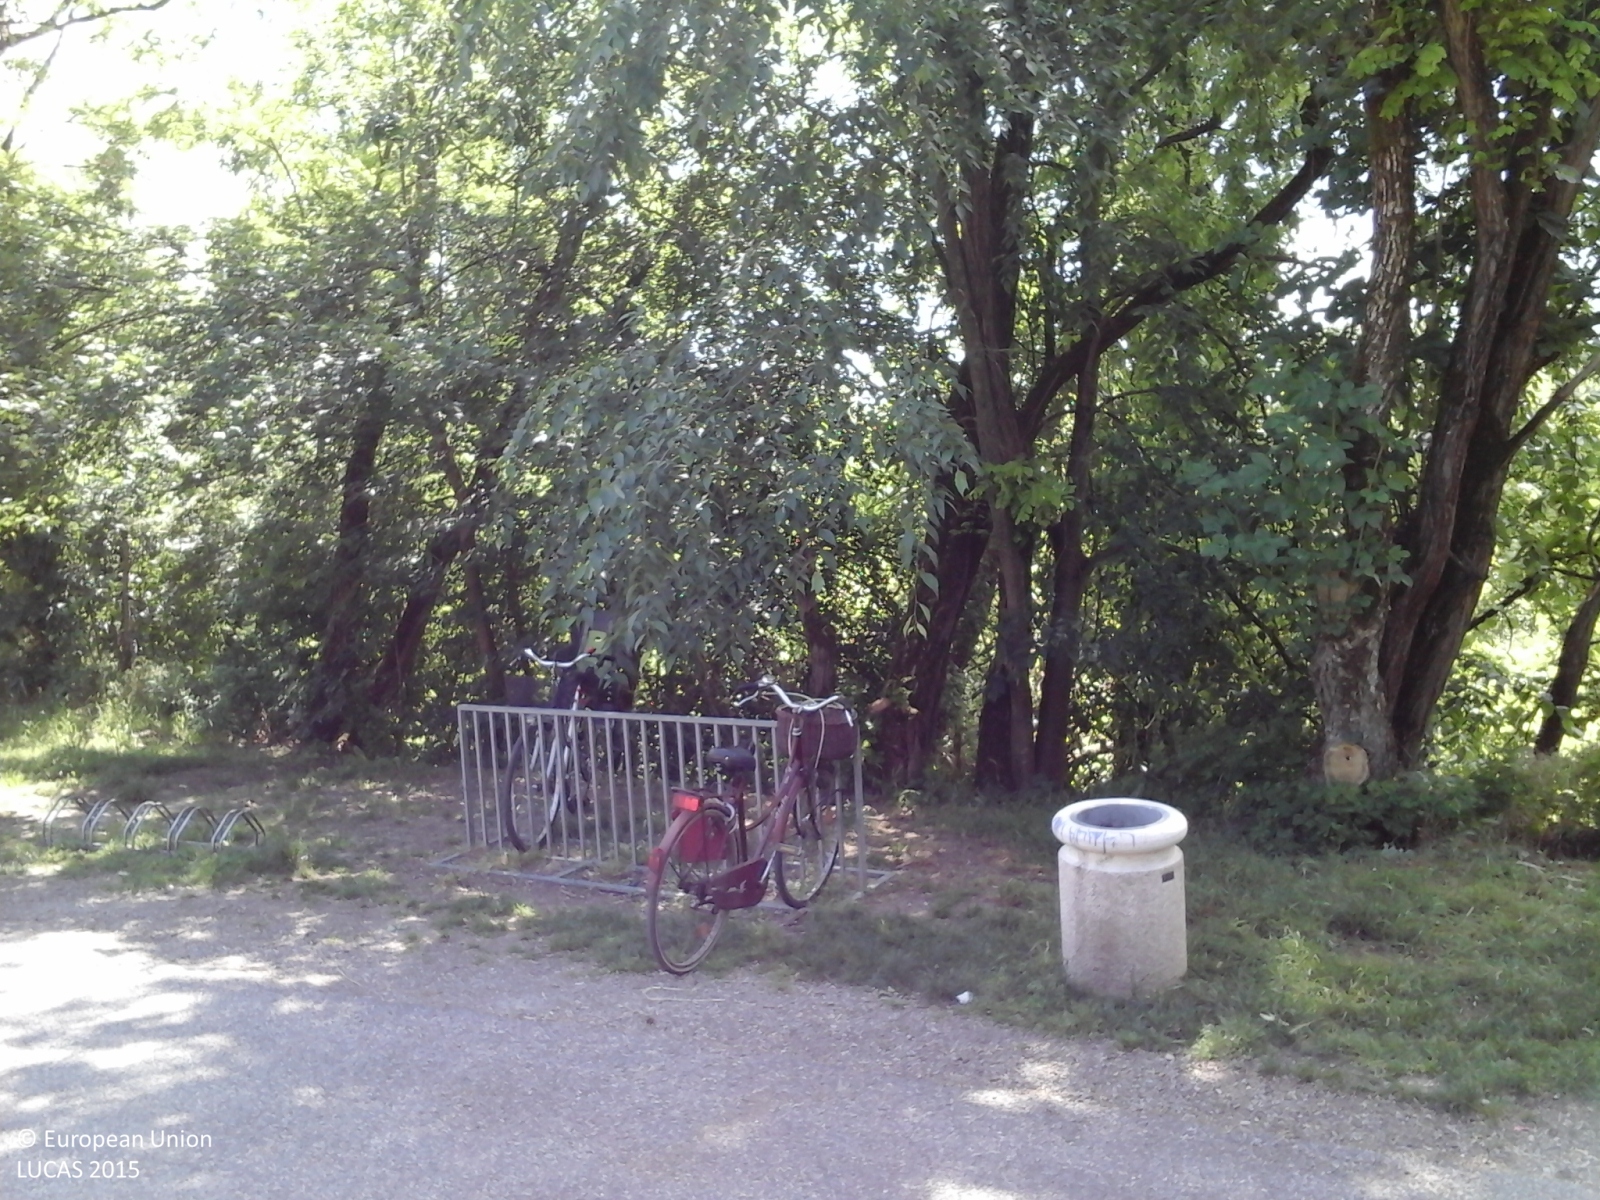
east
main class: Grassland
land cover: Grassland without tree/shrub cover
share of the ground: > 75 %
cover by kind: herbaceous plants 100 %
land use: Amenities, museums, leisure
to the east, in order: Grassland without tree/shrub cover; Paved roads, cycling and walking lanes; Broadleaved woodland; Inland fresh running water; Broadleaved woodland
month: May
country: IT
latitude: 44.6733
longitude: 10.6168
